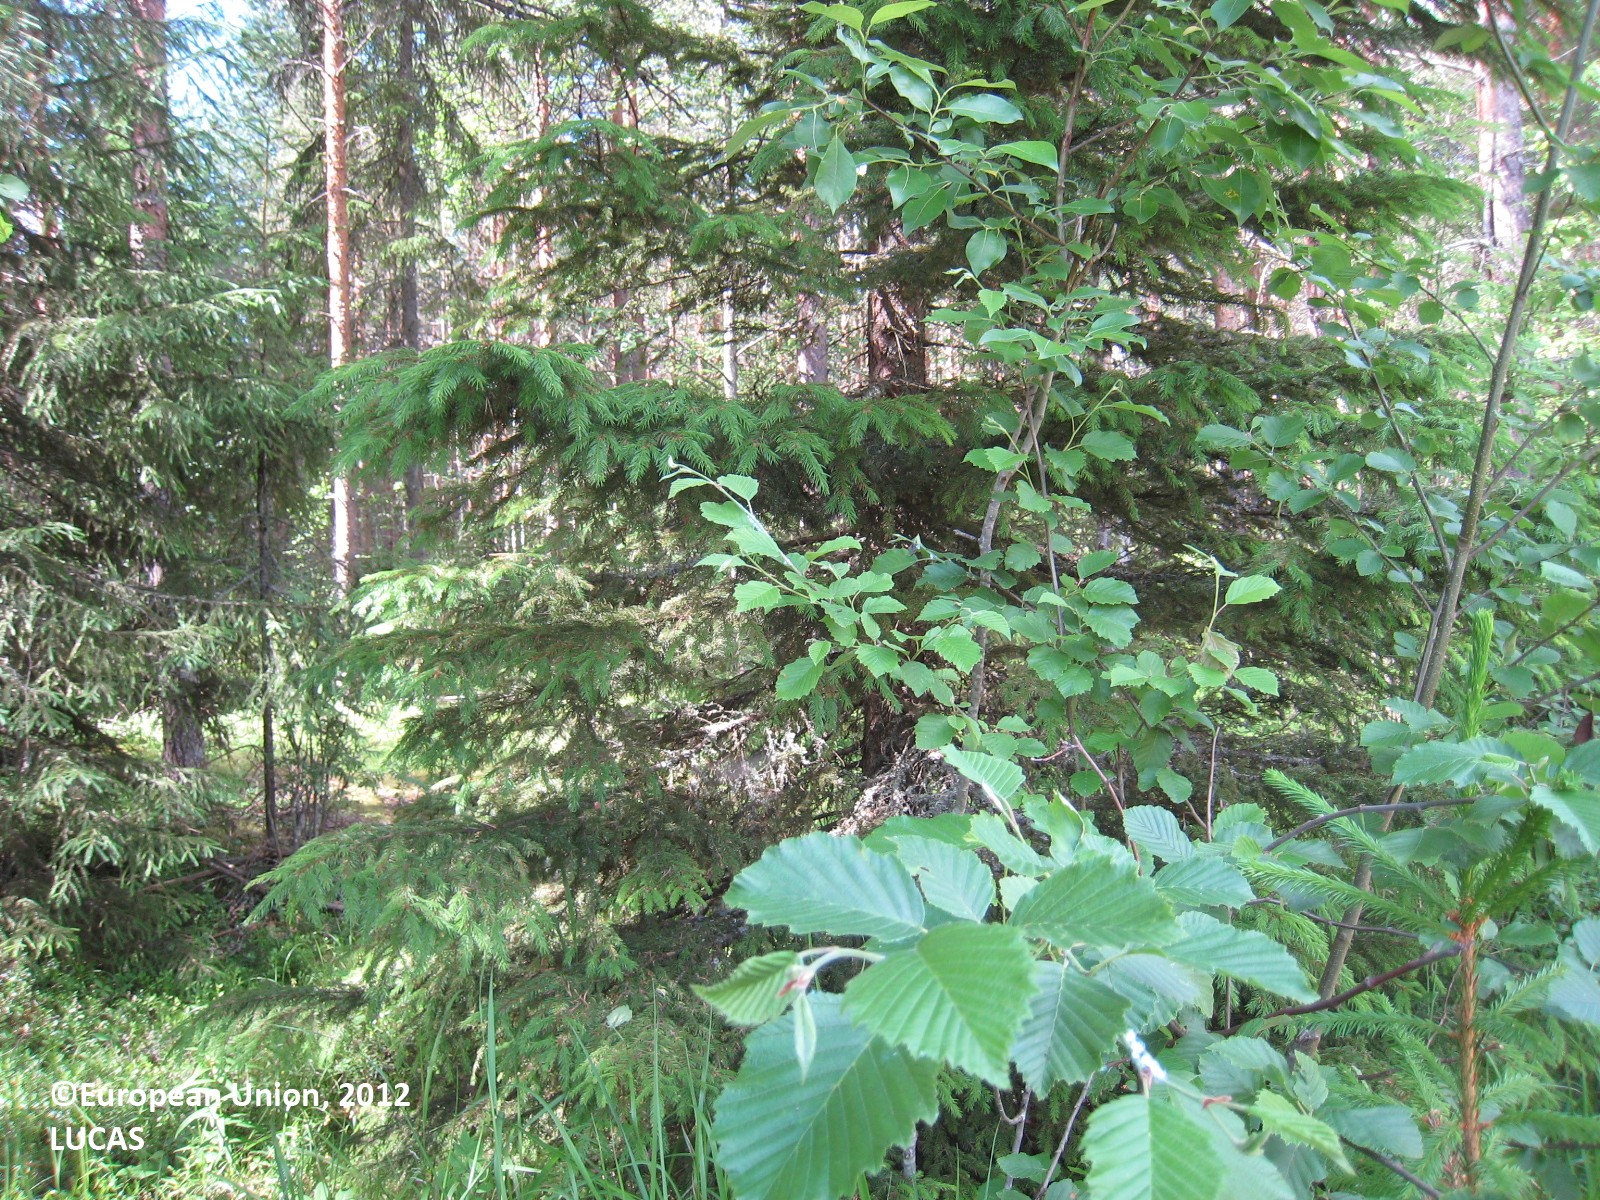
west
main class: Woodland
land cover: Other mixed woodland
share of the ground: 50 - 75 %
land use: Forestry
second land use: Road transport
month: July
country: FI
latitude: 63.2226
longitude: 25.6868
